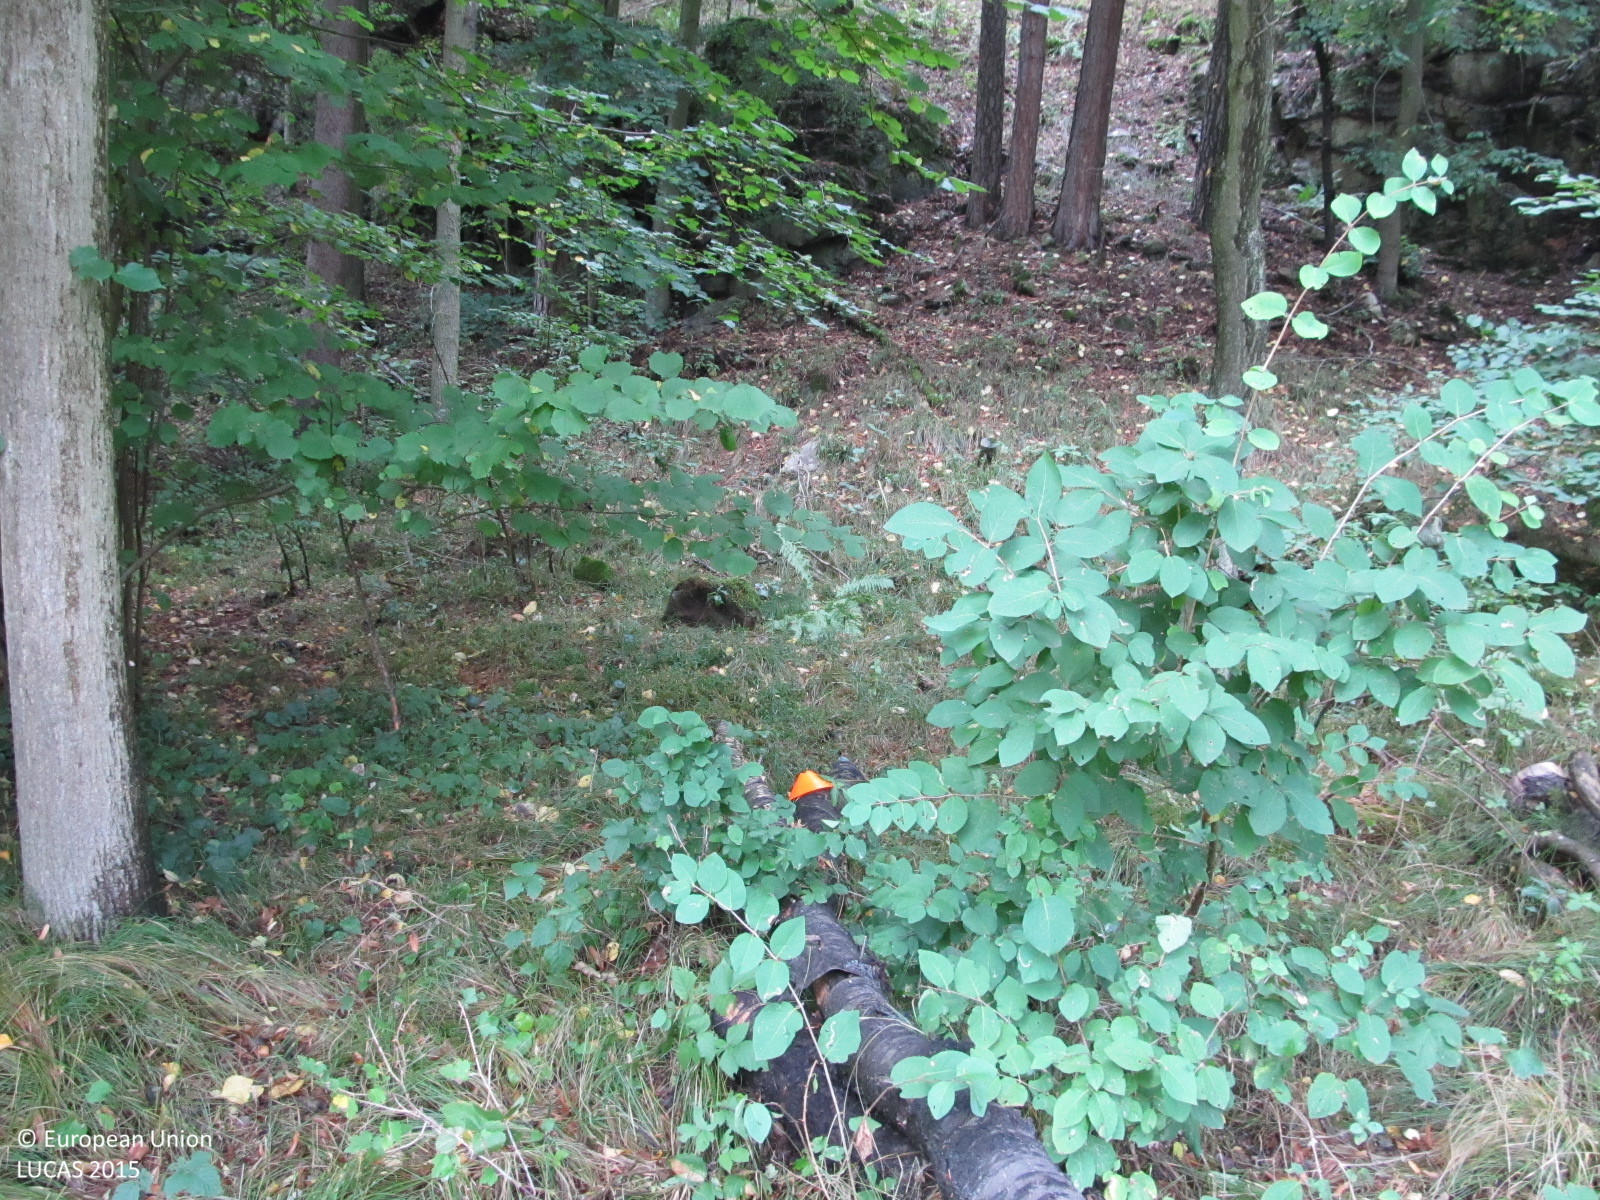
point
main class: Woodland
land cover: Other mixed woodland
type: hemiboreal forest and nemoral coniferous forest and mixed broadleaved-coniferous forest
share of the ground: > 75 %
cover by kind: broadleaved forest trees 50 %, coniferous forest trees 30 %, shrubs 10 %, herbaceous plants 10 %
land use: Forestry
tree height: > 5 m
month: August
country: AT
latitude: 48.8453
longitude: 15.4674
